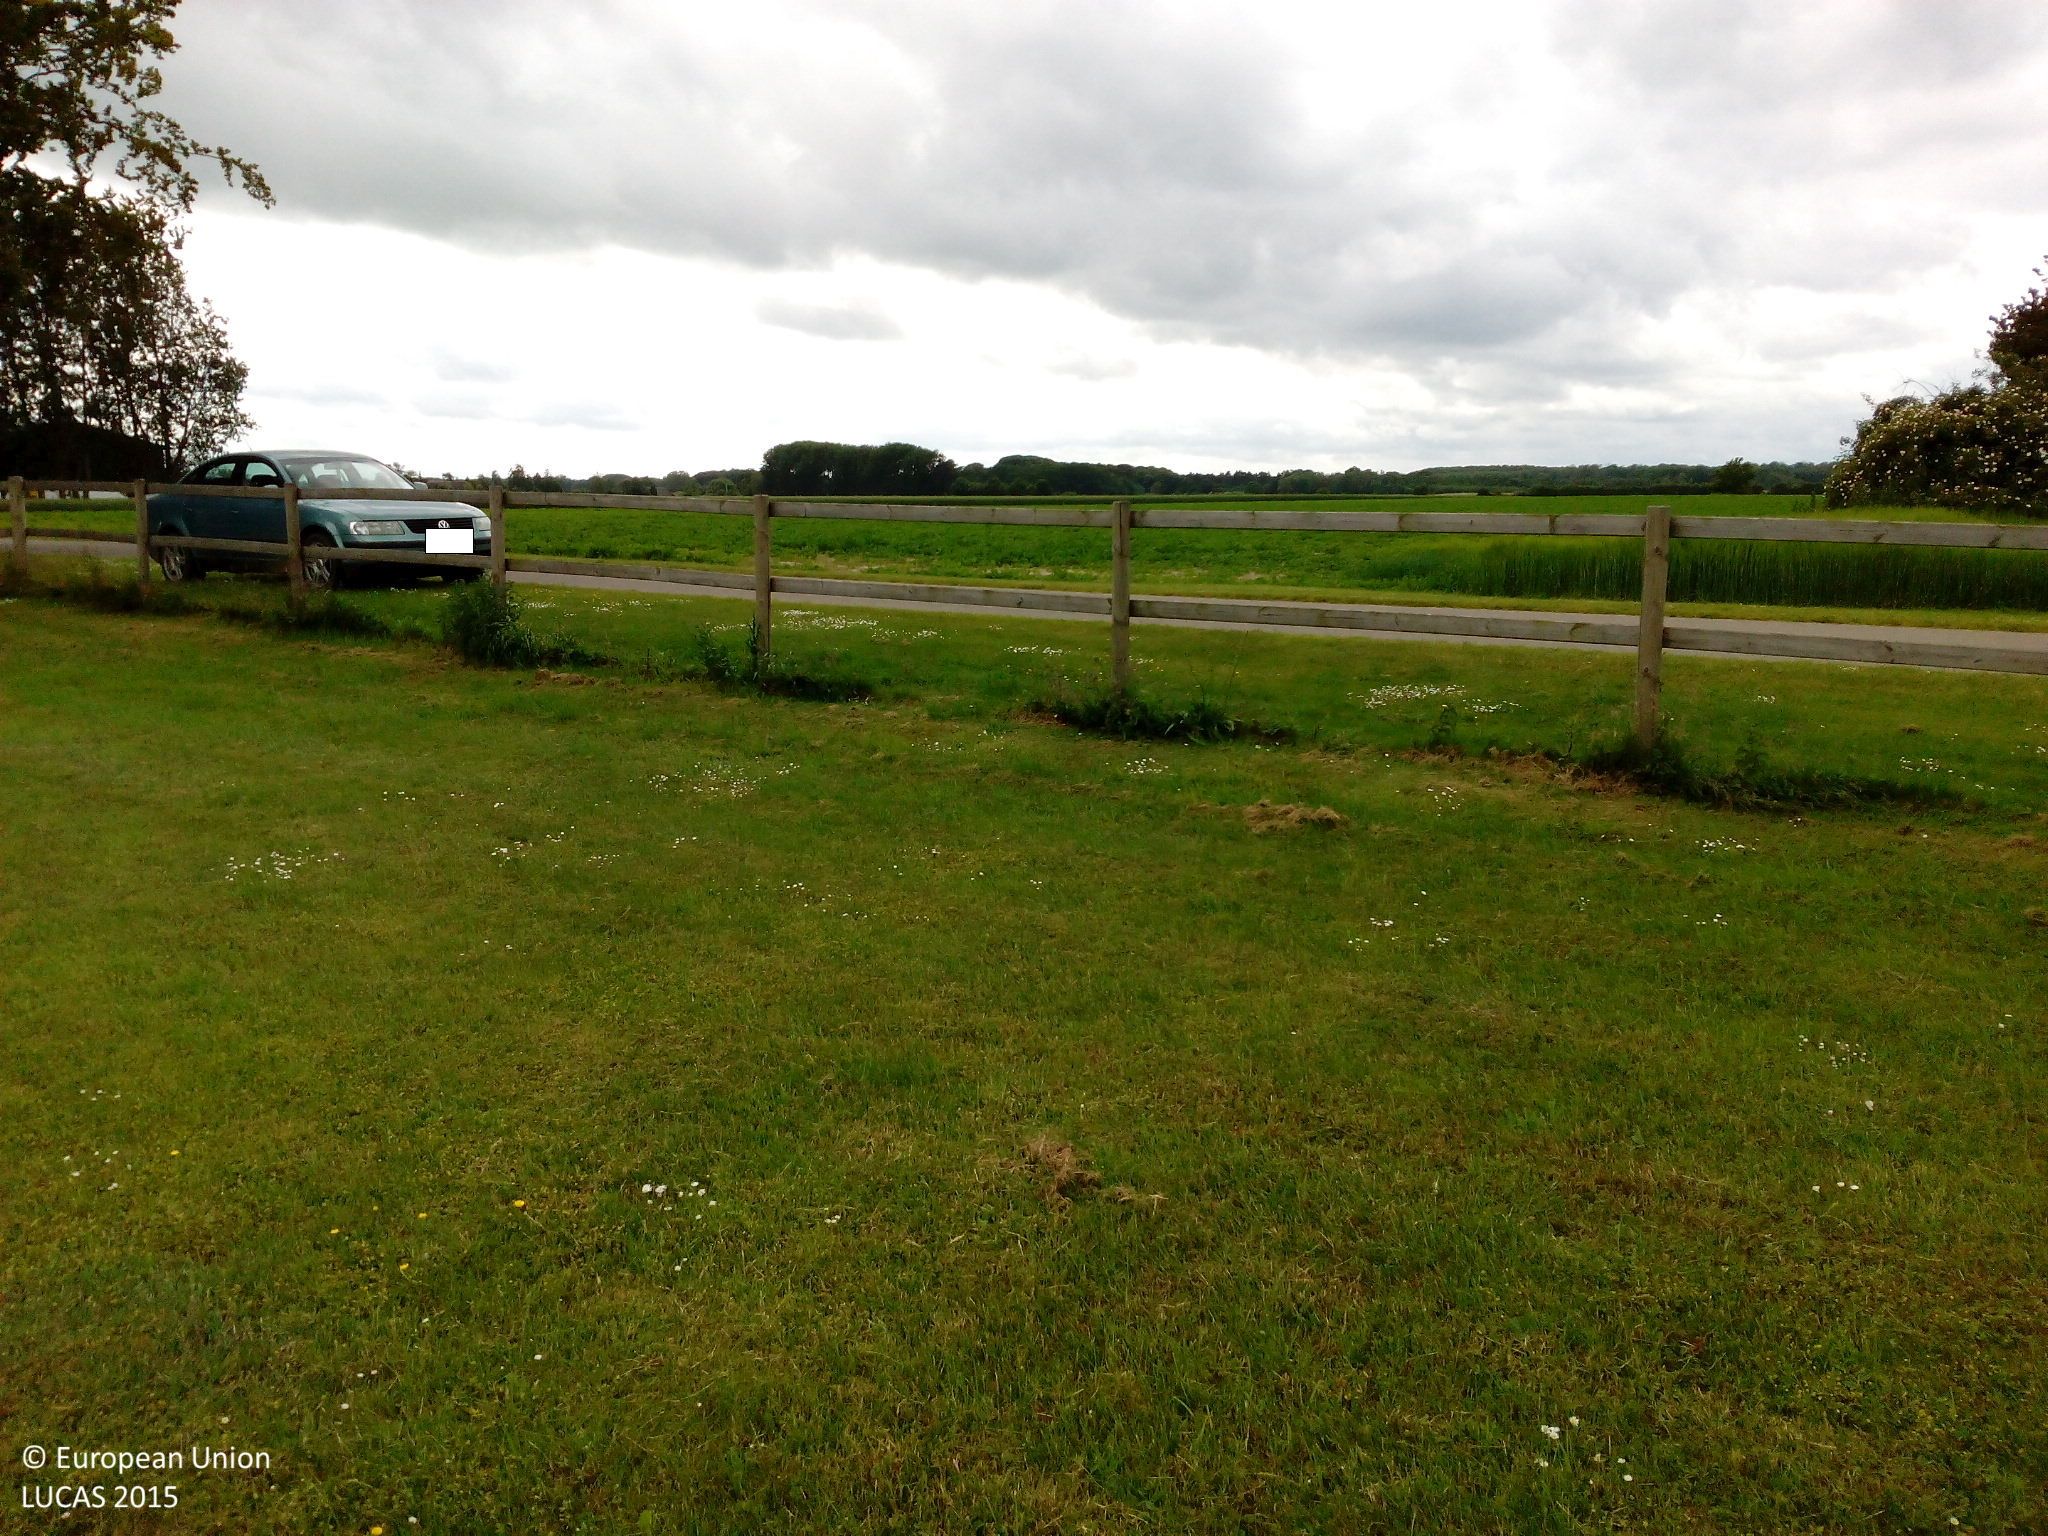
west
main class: Grassland
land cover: Grassland without tree/shrub cover
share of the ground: > 75 %
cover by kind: herbaceous plants 100 %
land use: Agriculture (excluding fallow land and kitchen gardens)
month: June
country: DK
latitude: 54.8470
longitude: 11.6341
